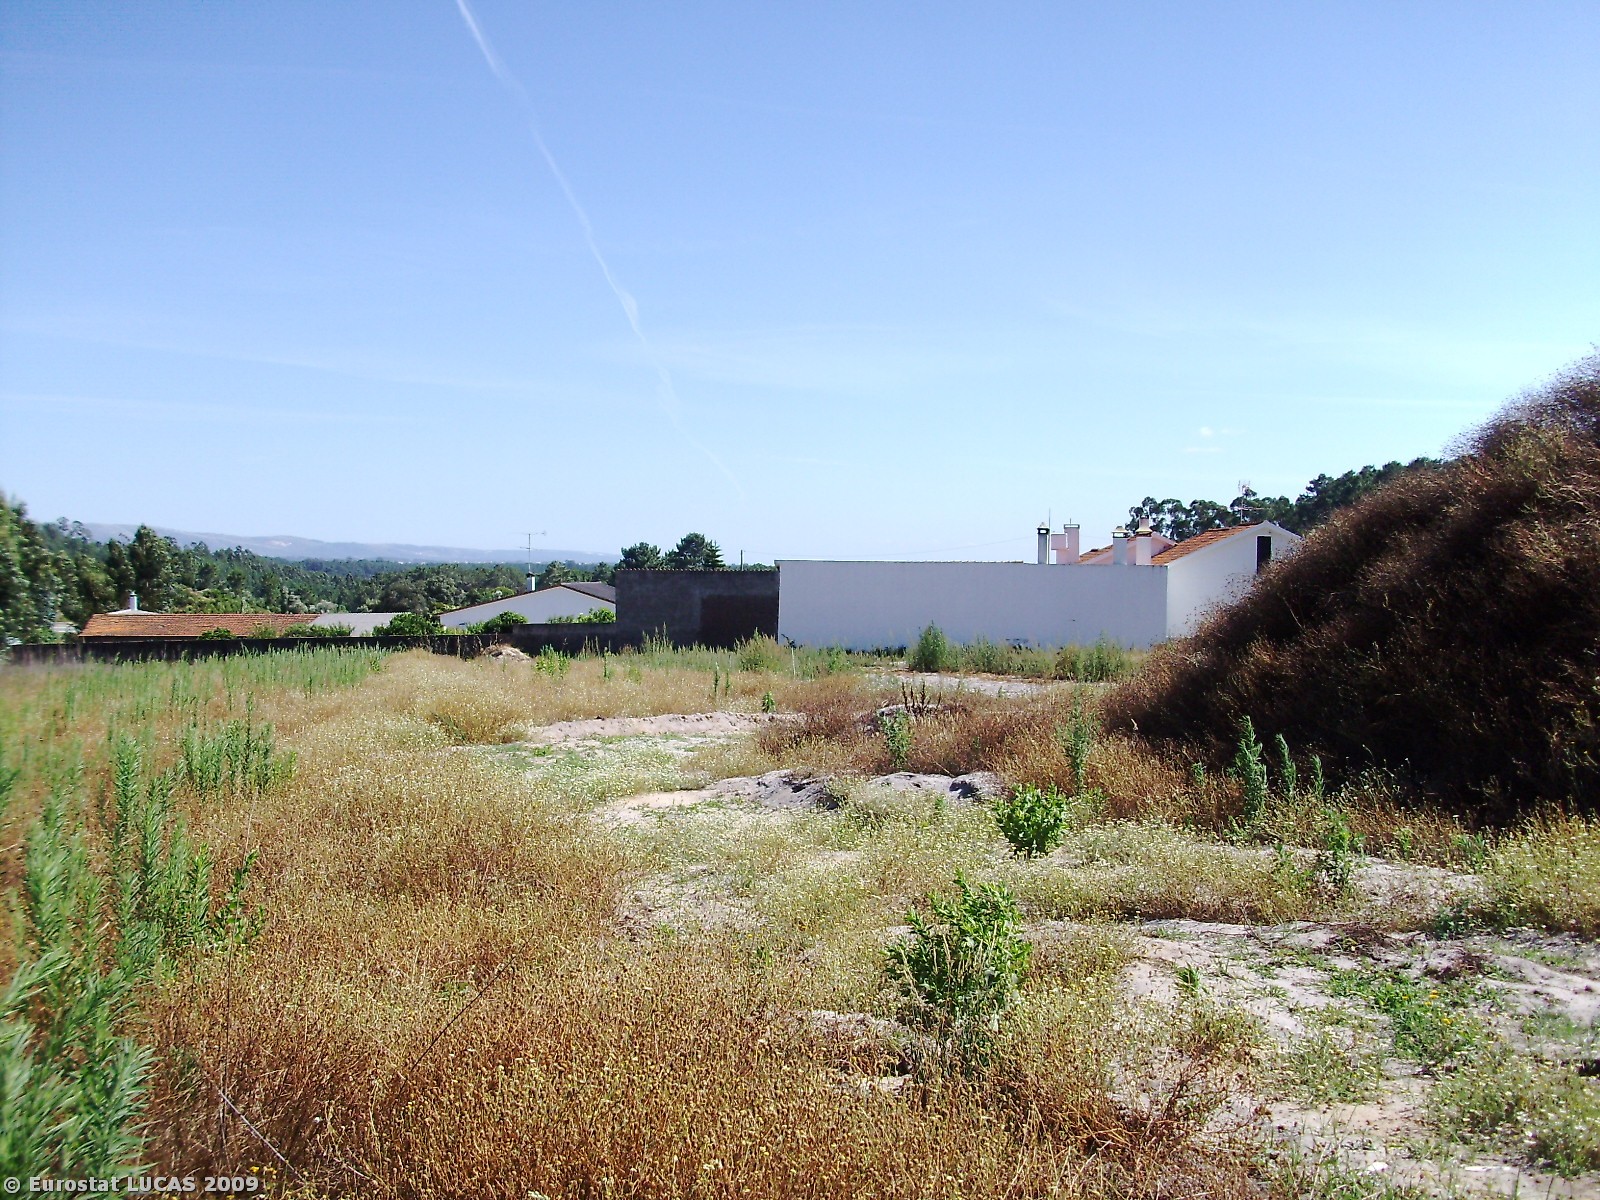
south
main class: Grassland
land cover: Spontaneously vegetated surfaces
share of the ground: > 75 %
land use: Fallow land
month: July
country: PT
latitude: 39.6810
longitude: -8.9415
